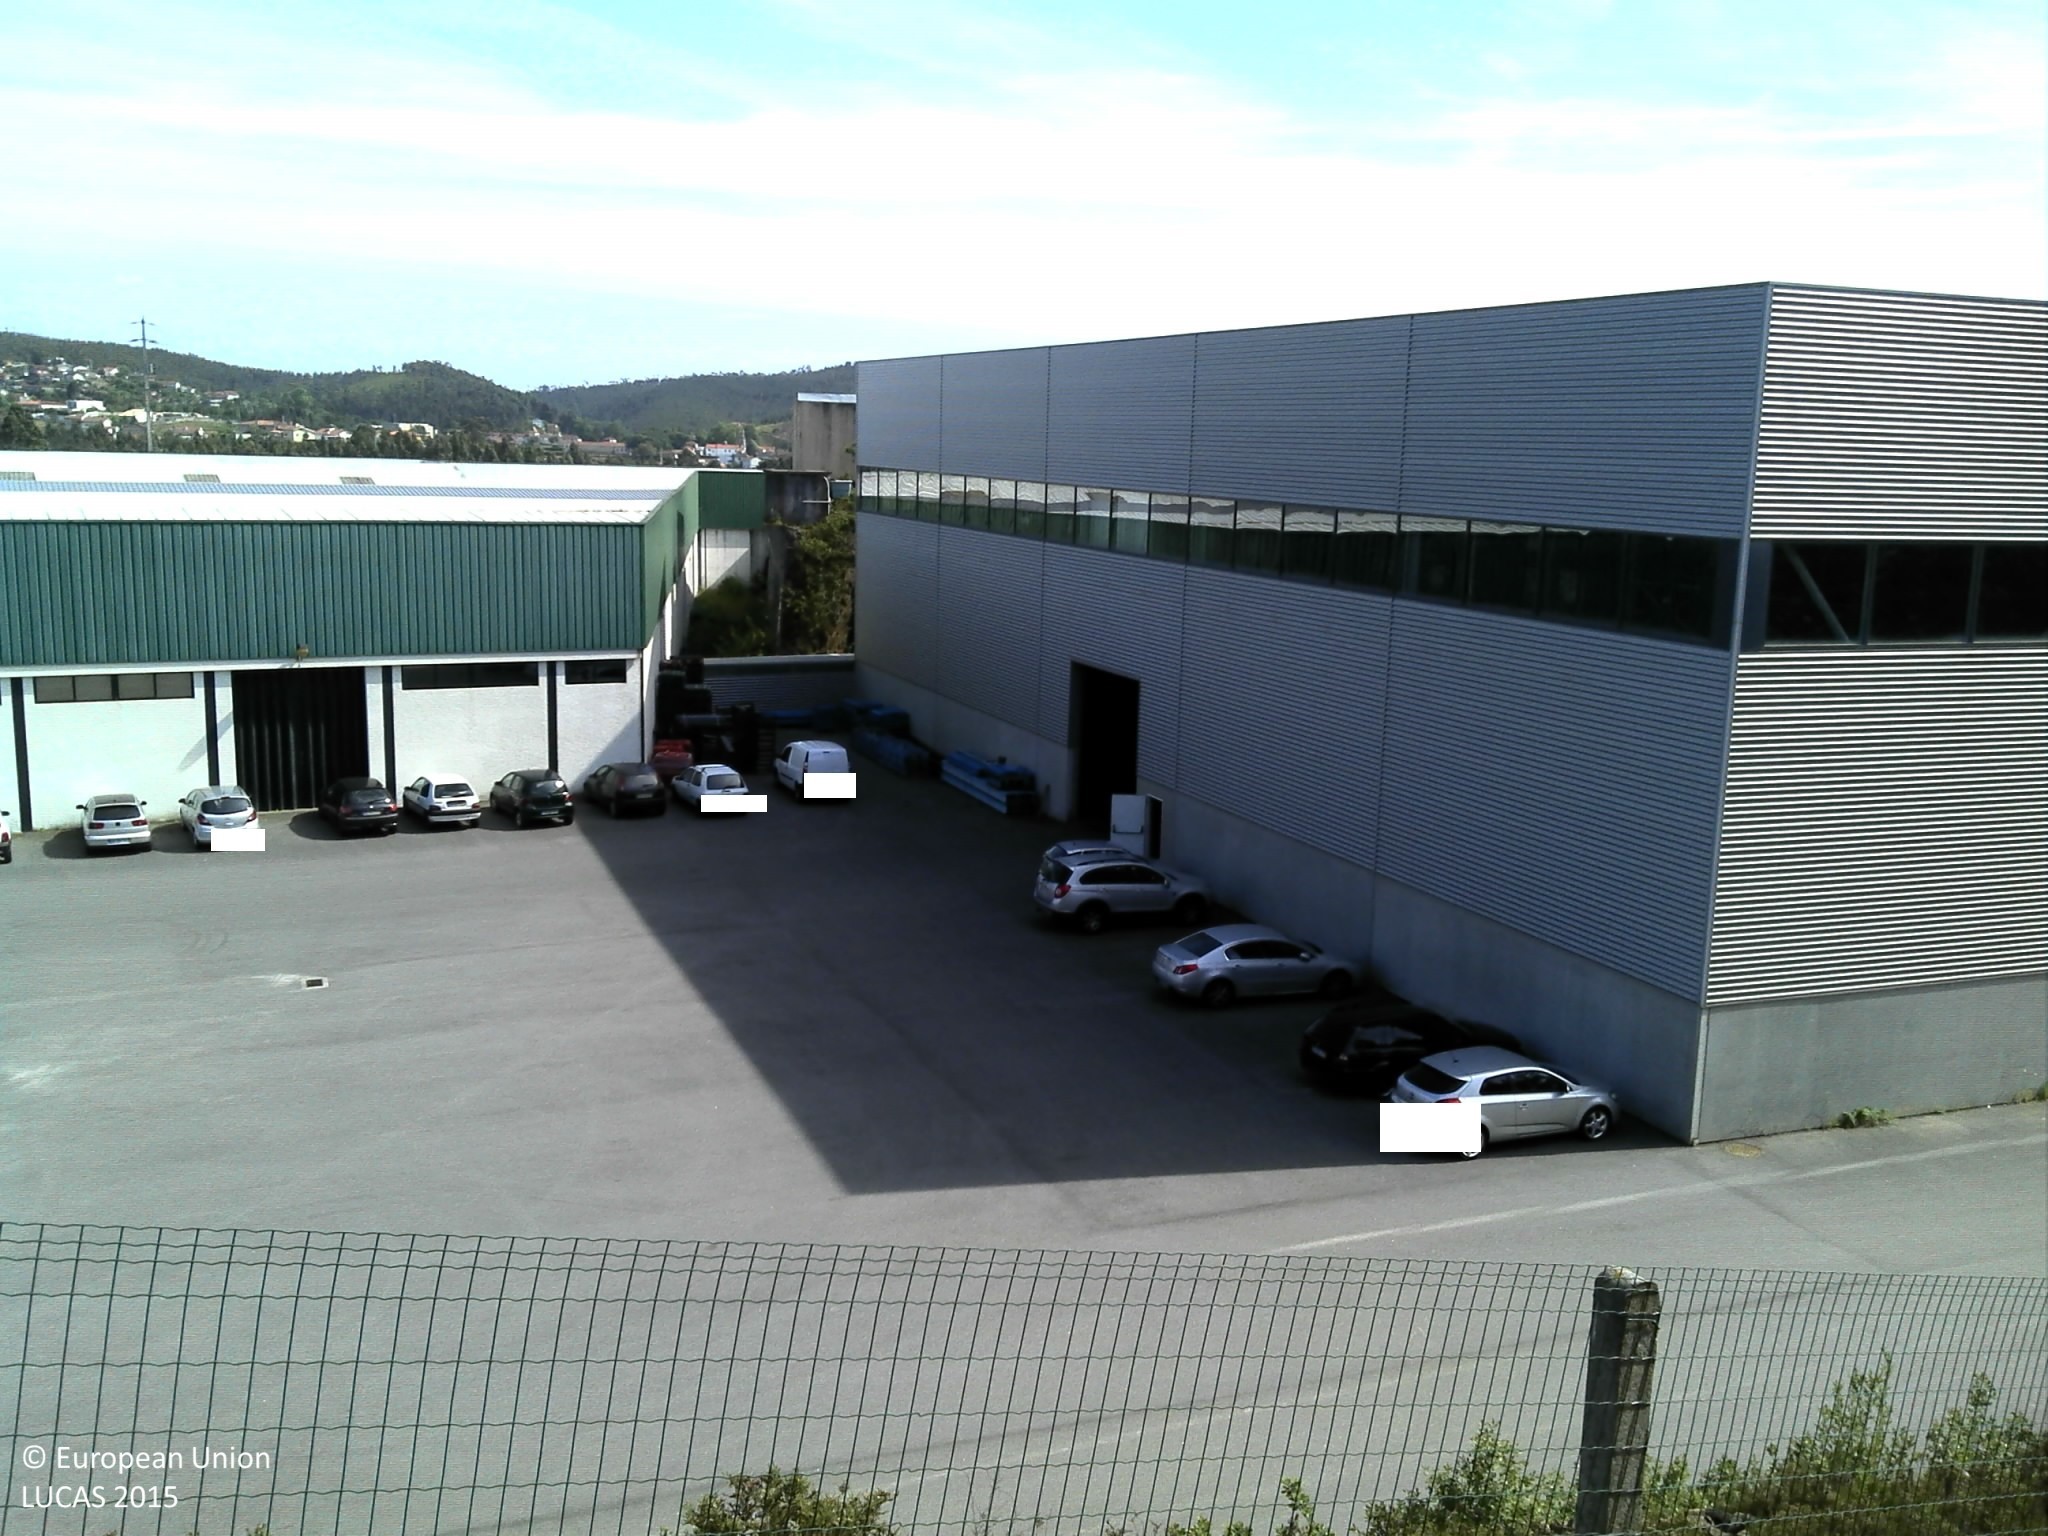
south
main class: Shrubland
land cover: Shrubland with sparse tree cover
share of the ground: 50 - 75 %
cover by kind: shrubs 65 %, consolidated bare surface 15 %, unconsolidated bare surface 10 %, broadleaved forest trees 5 %, herbaceous plants 5 %
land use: Forestry
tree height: > 5 m
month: May
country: PT
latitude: 41.2696
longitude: -8.4743
